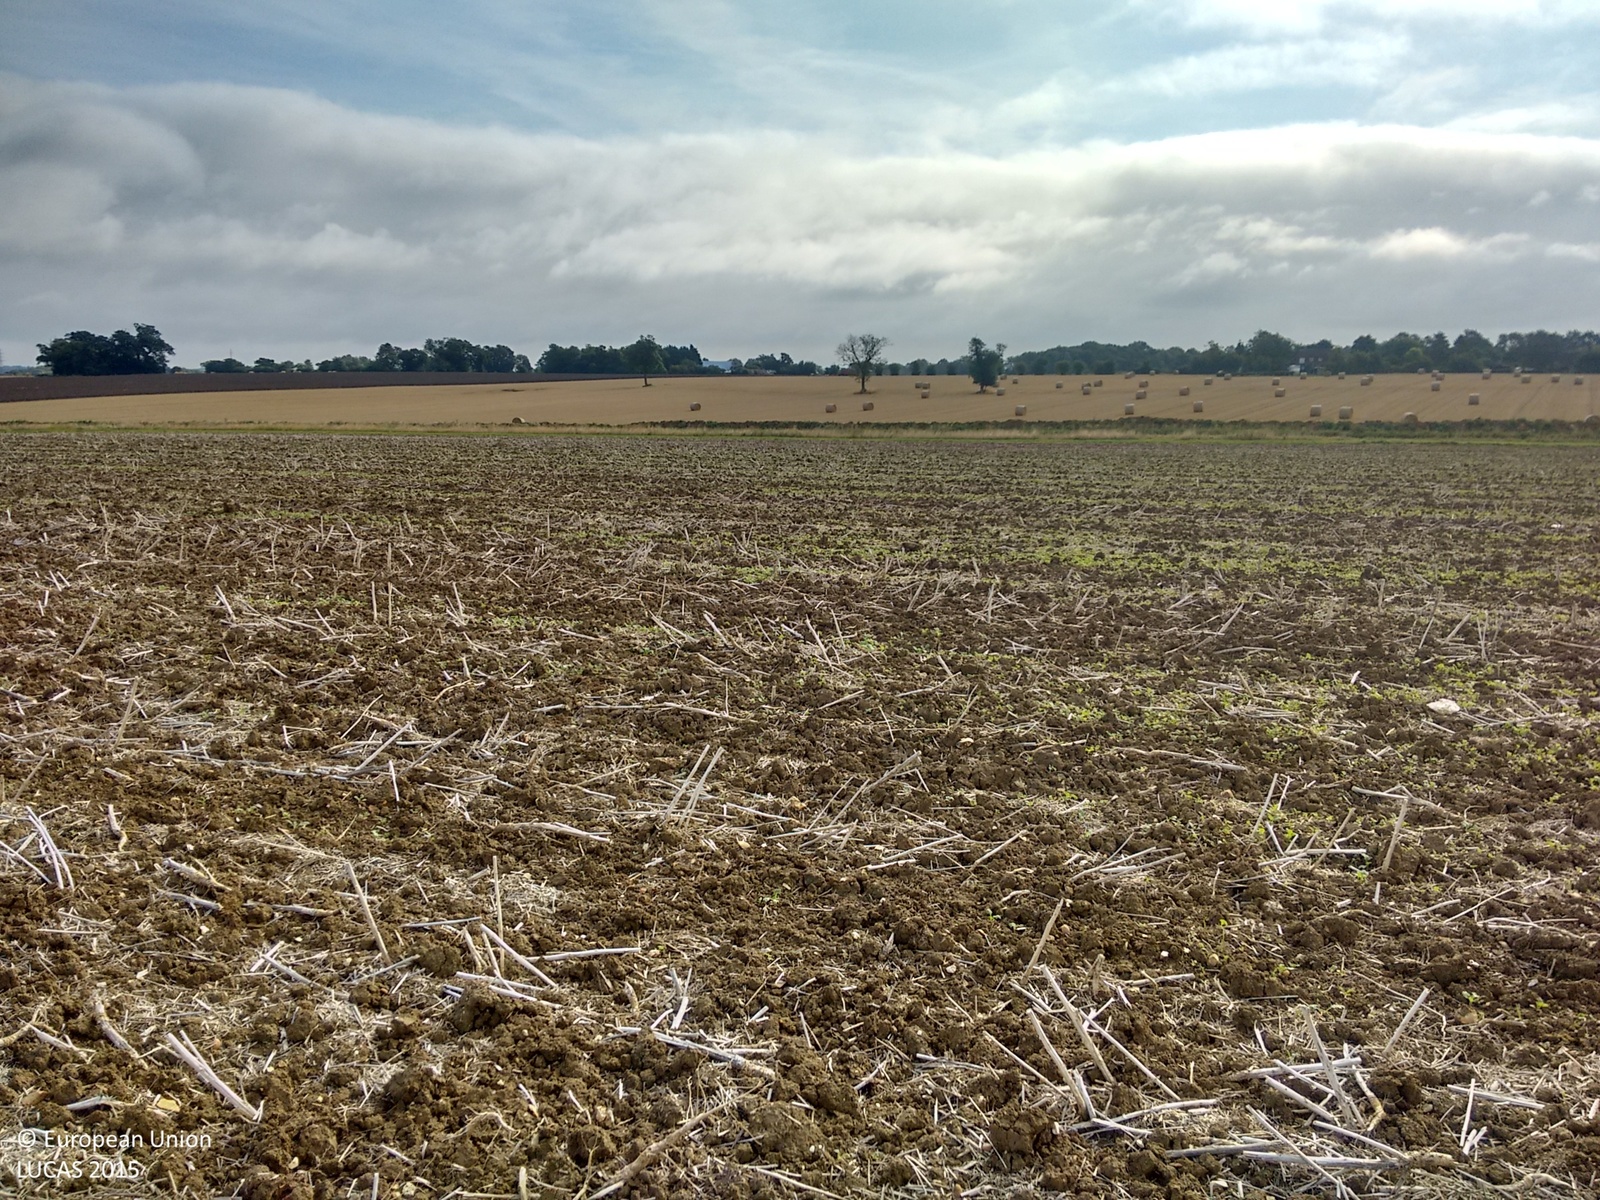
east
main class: Cropland
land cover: Rape and turnip rape
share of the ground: 25 - 50 %
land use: Agriculture (excluding fallow land and kitchen gardens)
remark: Harvested field
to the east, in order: Rape and turnip rape; Grassland without tree/shrub cover; Ditches and canals; Grass margins; Common wheat
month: September
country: GB
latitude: 52.1607
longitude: 0.9864
